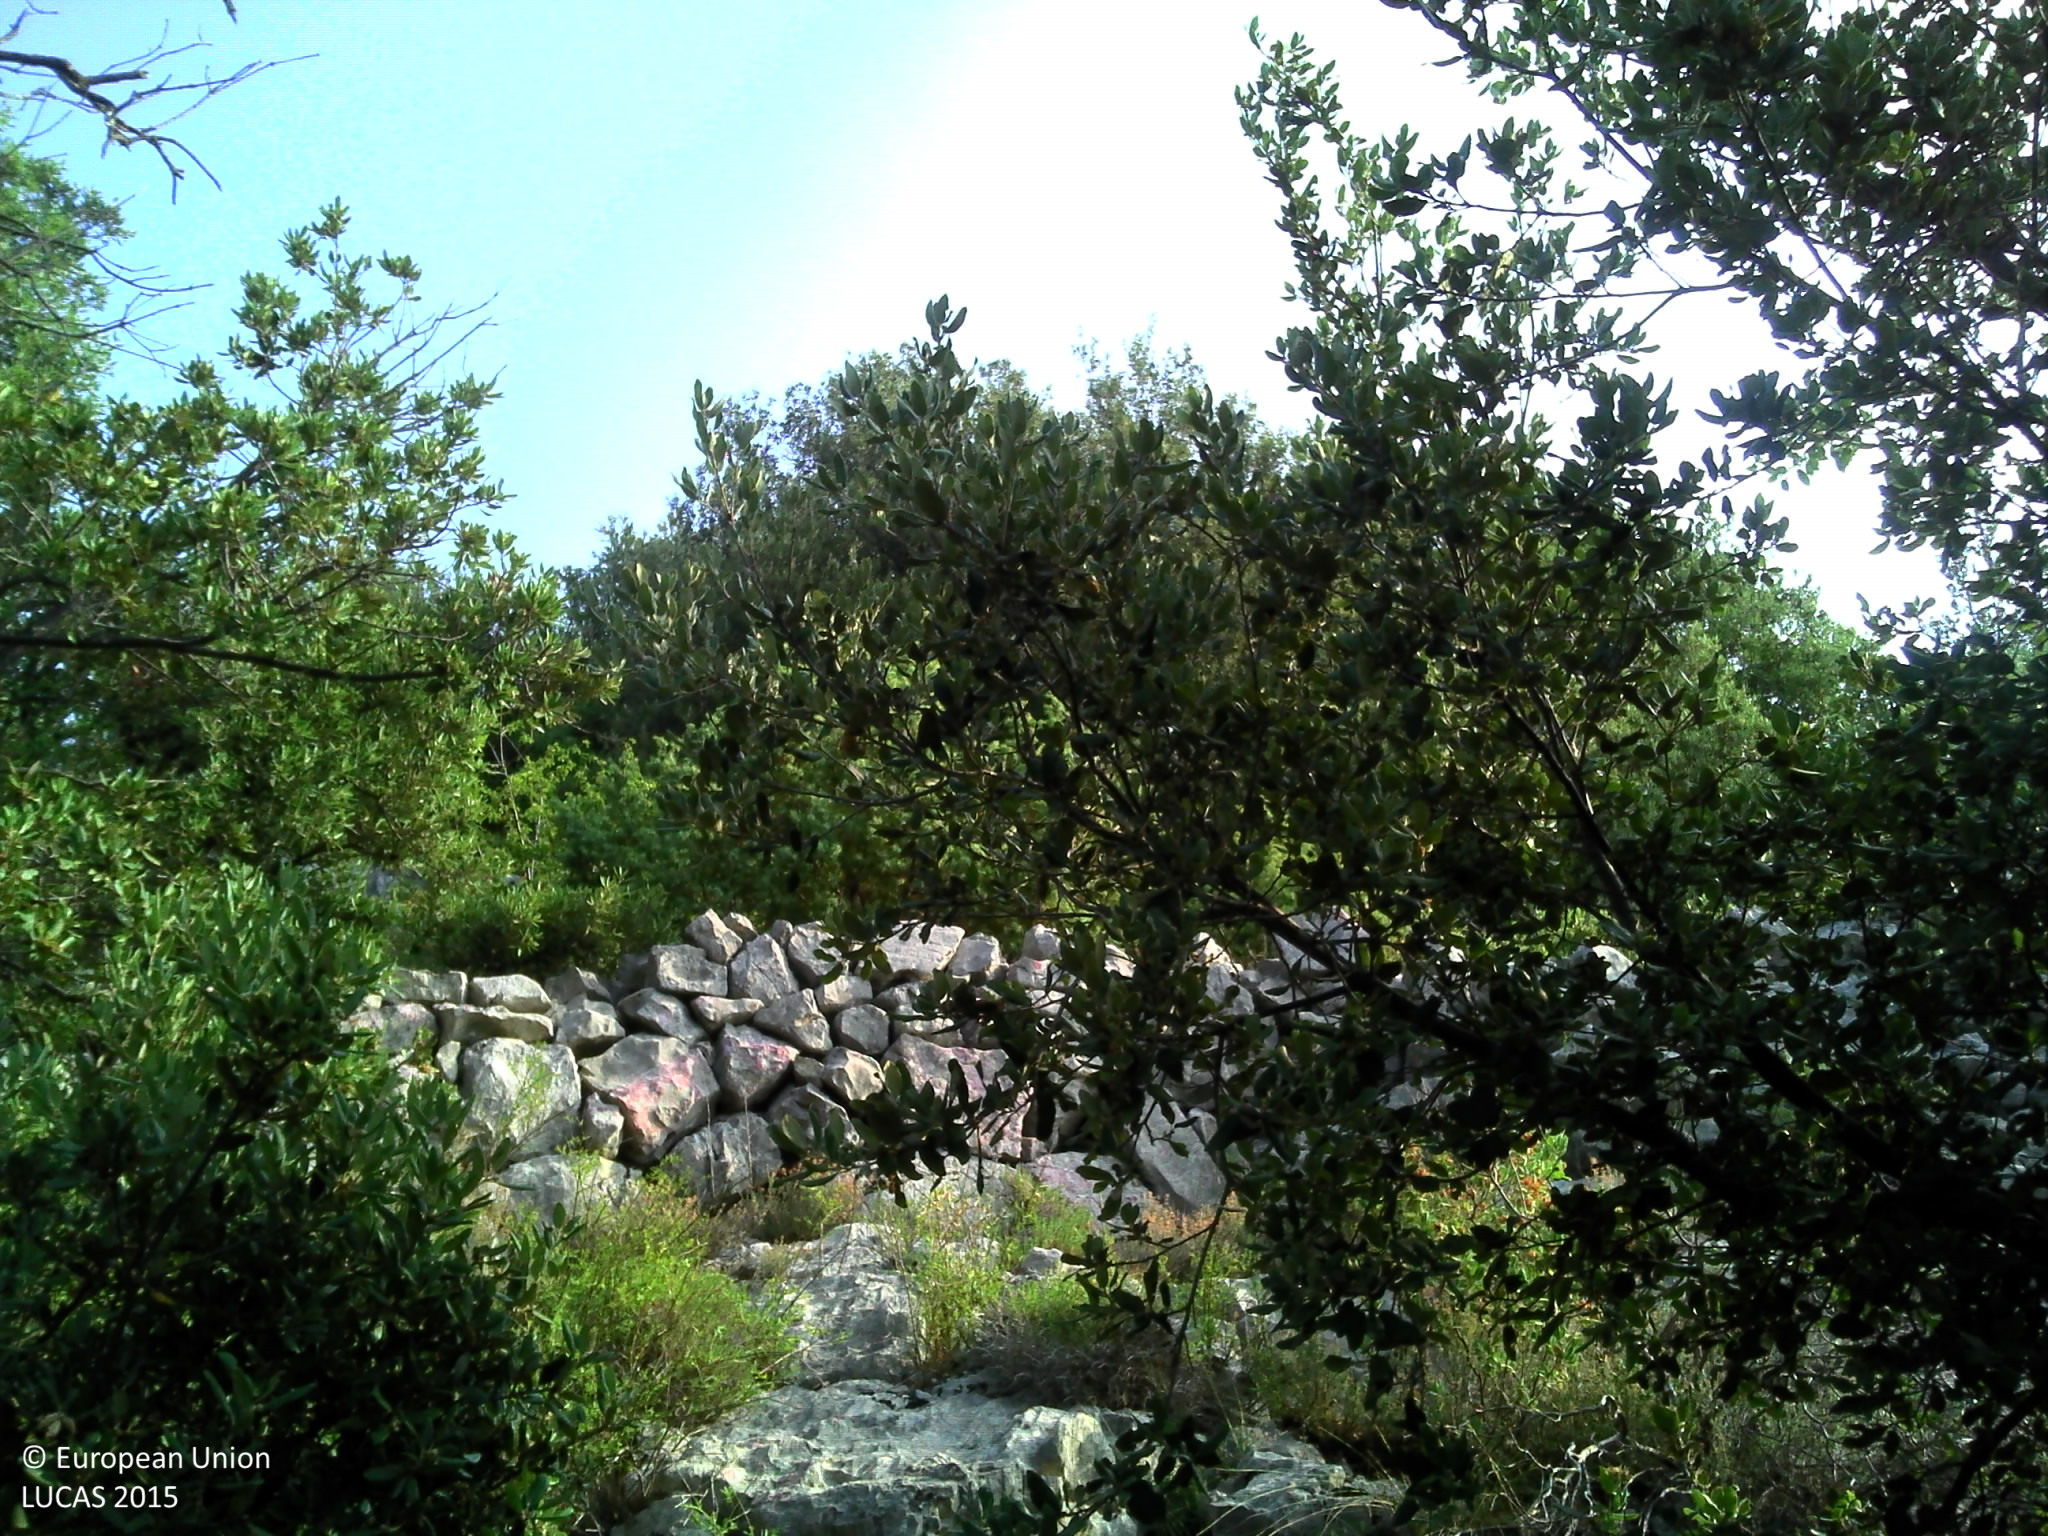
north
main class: Woodland
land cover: Broadleaved woodland
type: broadleaved evergreen forest
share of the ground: 25 - 50 %
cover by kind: broadleaved forest trees 35 %, shrubs 30 %, consolidated bare surface 20 %, herbaceous plants 10 %, unconsolidated bare surface 5 %
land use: Semi-natural and natural areas not in use
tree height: > 5 m
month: July
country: FR
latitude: 43.7068
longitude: 6.8430
